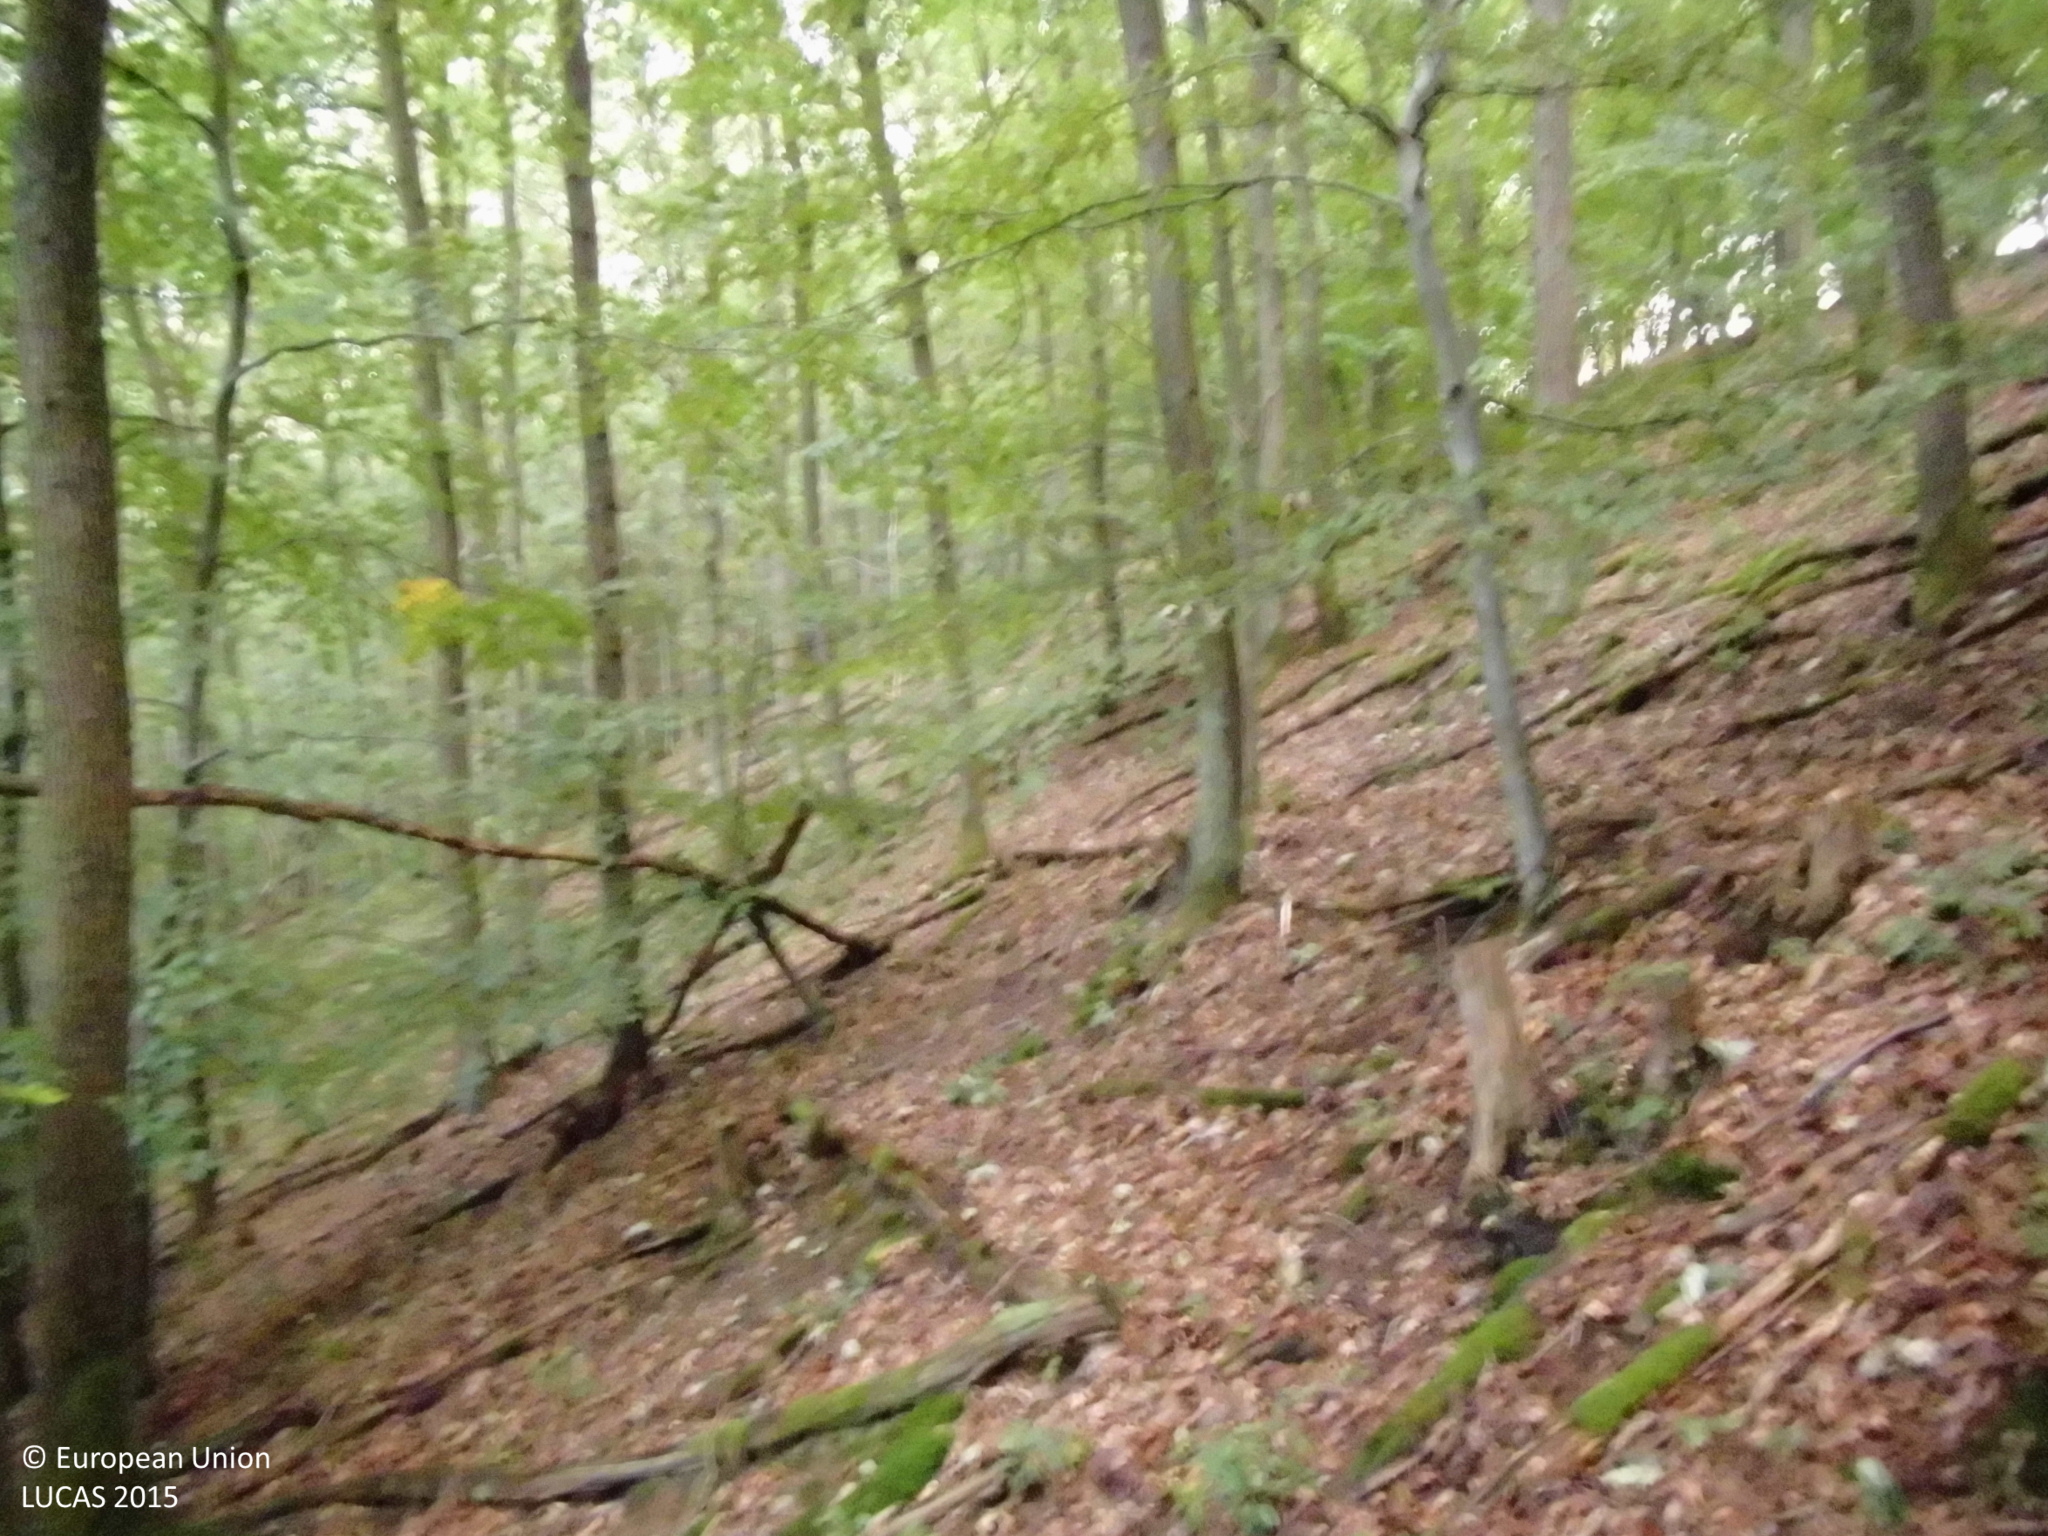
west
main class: Woodland
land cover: Broadleaved woodland
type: mesophytic deciduous forest
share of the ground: > 75 %
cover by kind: broadleaved forest trees 100 %
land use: Forestry
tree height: > 5 m
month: September
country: DE
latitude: 50.5874
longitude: 7.4437
